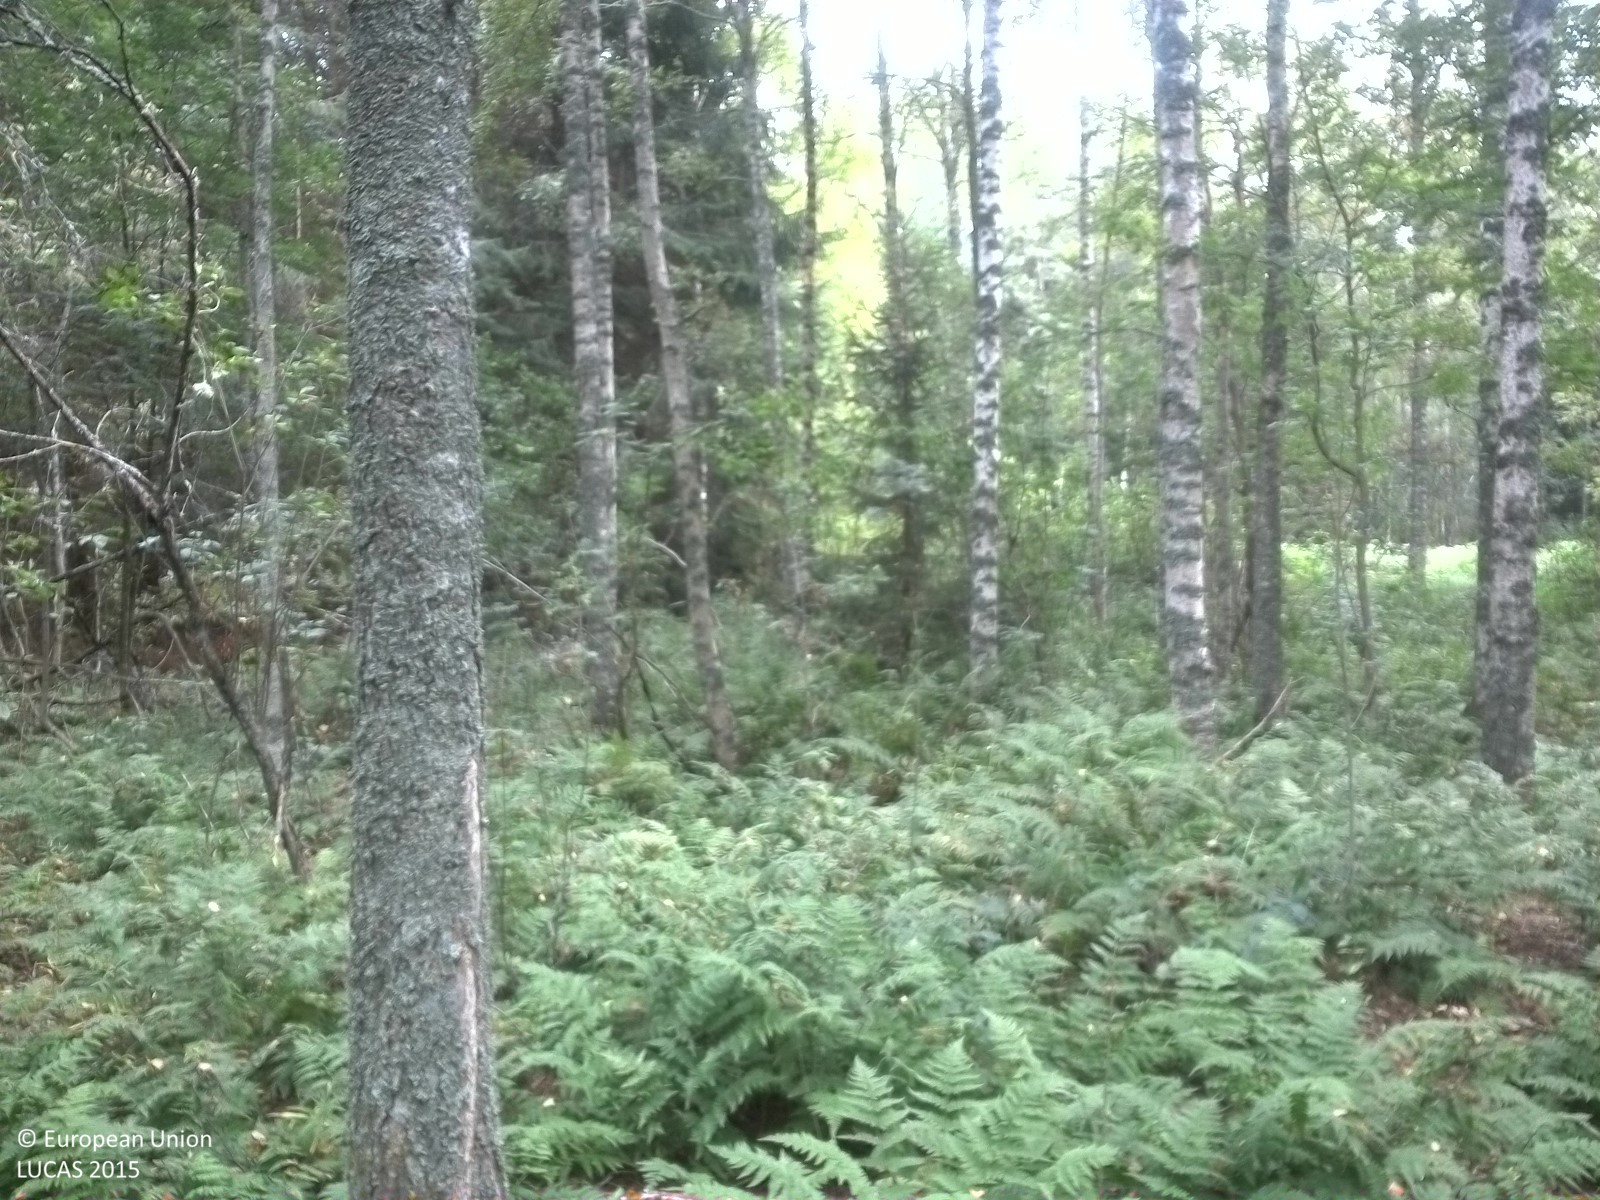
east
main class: Woodland
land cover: Broadleaved woodland
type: hemiboreal forest and nemoral coniferous forest and mixed broadleaved-coniferous forest
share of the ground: 25 - 50 %
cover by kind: broadleaved forest trees 35 %, herbaceous plants 35 %, unconsolidated bare surface 20 %, coniferous forest trees 5 %, lichens and mosses 5 %
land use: Forestry
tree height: > 5 m
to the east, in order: Broadleaved woodland; Spruce dominated coniferous woodland; Ditches and canals; Grass margins; Paved roads, cycling and walking lanes; Grass margins; Spruce dominated mixed woodland; Electric lines; Spruce dominated mixed woodland; Ditches and canals; Spruce dominated mixed woodland
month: August
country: SE
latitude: 59.3001
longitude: 15.8749
